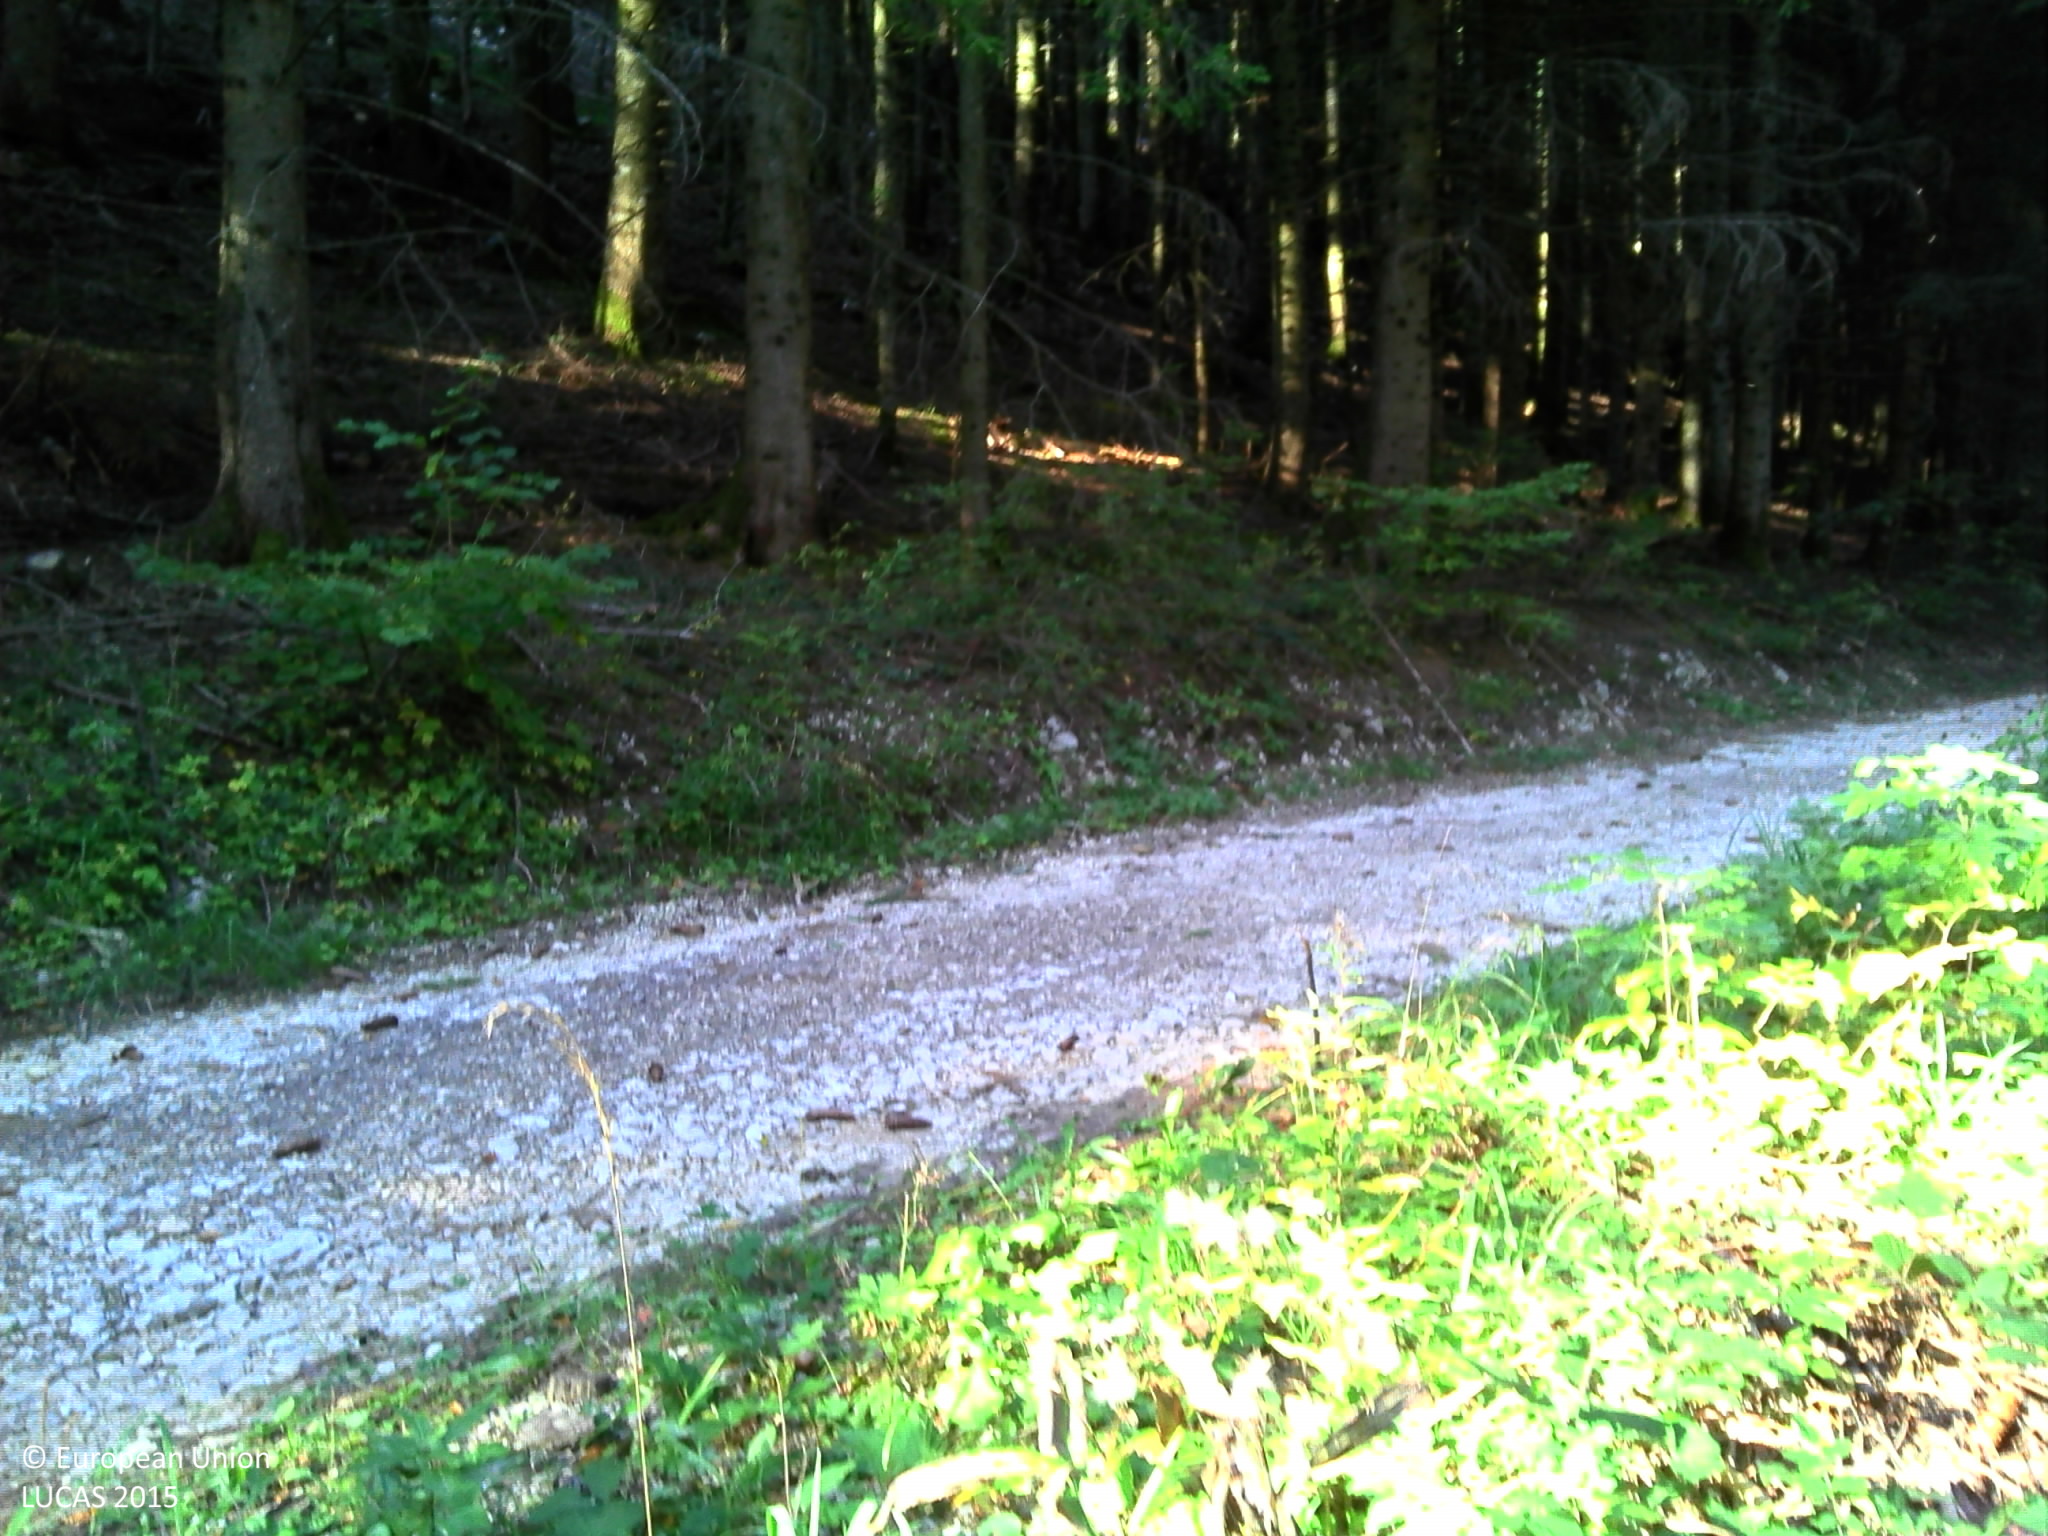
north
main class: Woodland
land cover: Spruce dominated coniferous woodland
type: exotic forest
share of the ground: > 75 %
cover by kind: coniferous forest trees 90 %, herbaceous plants 10 %
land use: Forestry
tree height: > 5 m
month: October
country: FR
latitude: 46.9213
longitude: 6.3911
